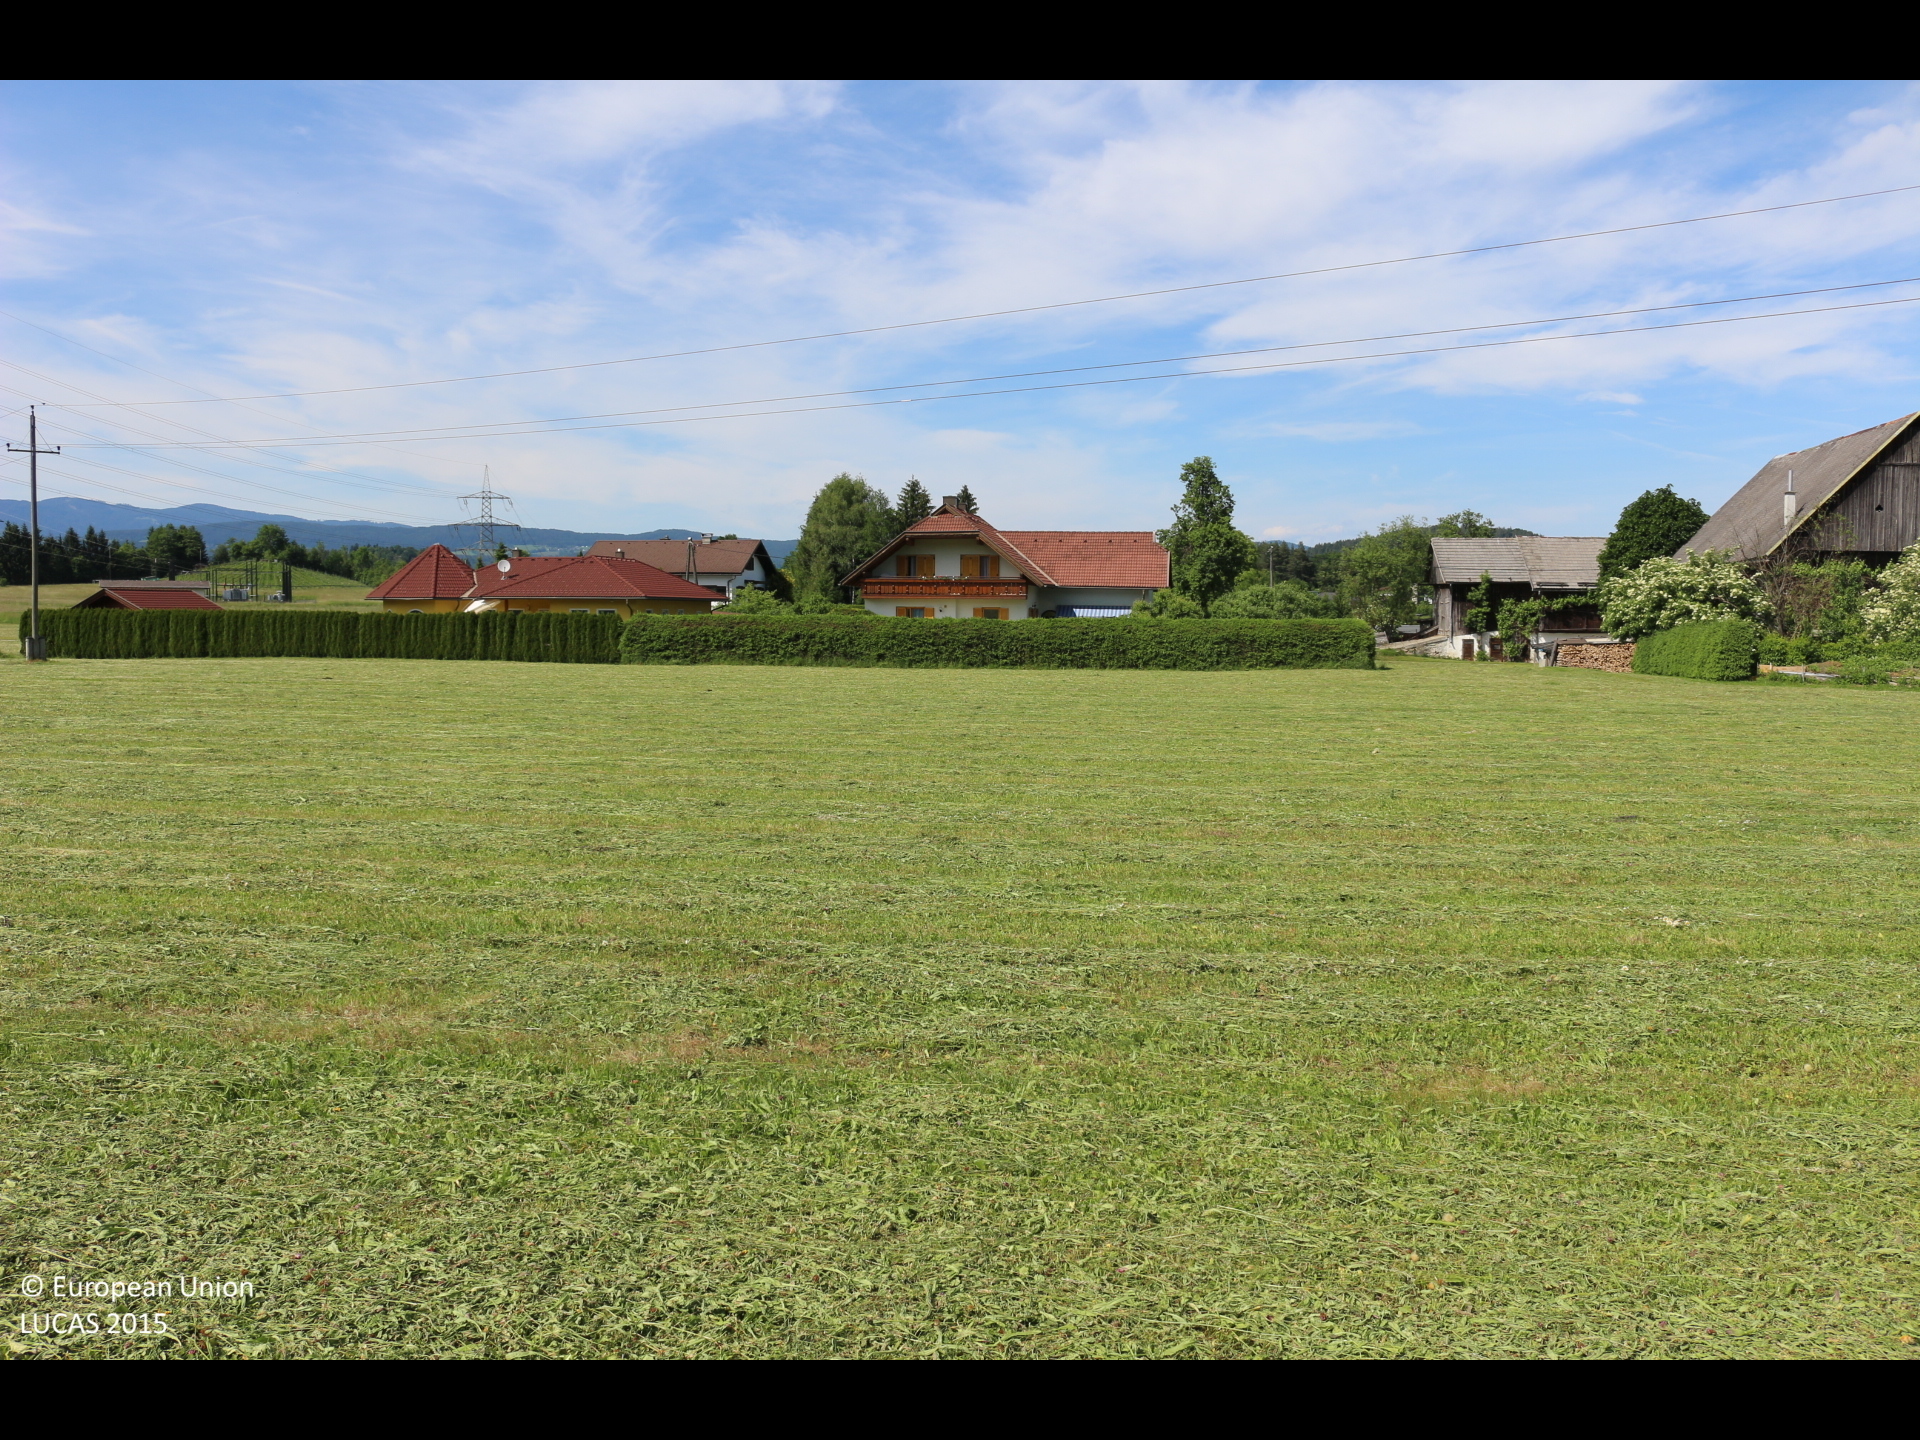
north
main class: Grassland
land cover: Grassland without tree/shrub cover
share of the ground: > 75 %
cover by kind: herbaceous plants 100 %
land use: Agriculture (excluding fallow land and kitchen gardens)
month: May
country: AT
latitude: 46.5639
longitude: 14.0283
